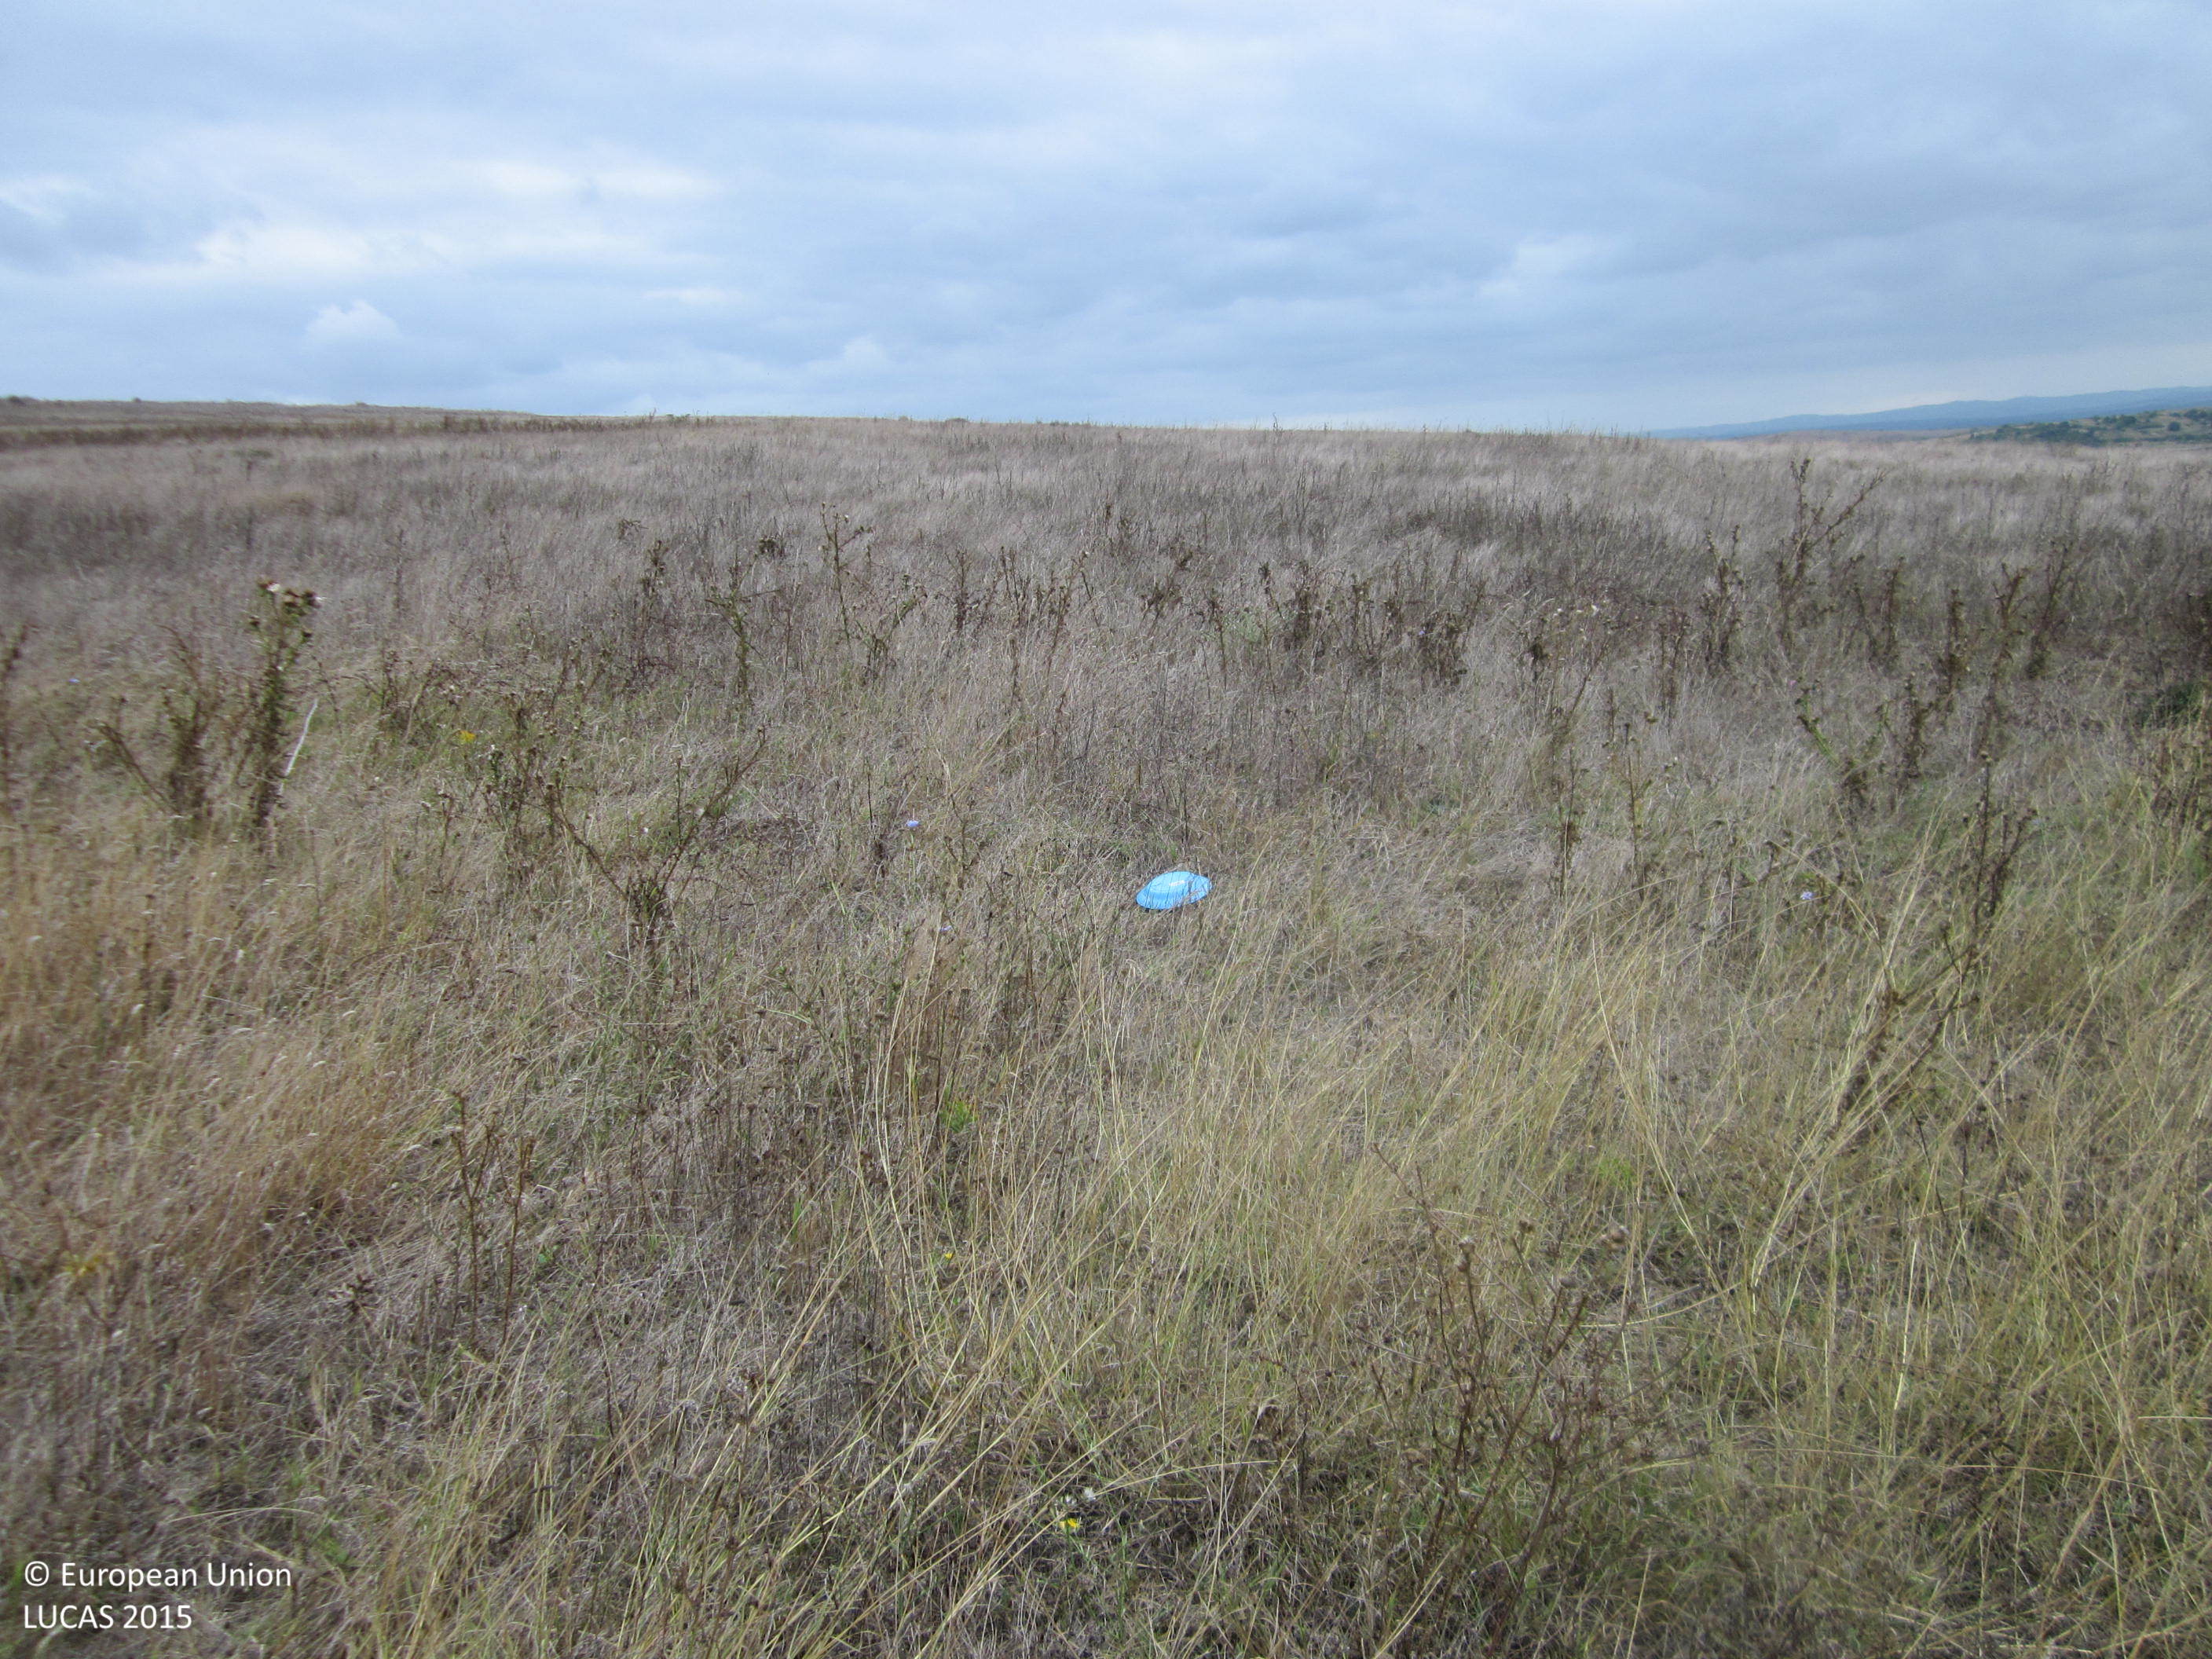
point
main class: Grassland
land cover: Grassland without tree/shrub cover
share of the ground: > 75 %
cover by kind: herbaceous plants 100 %
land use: Agriculture (excluding fallow land and kitchen gardens)
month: September
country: BG
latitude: 42.4569
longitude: 27.3190
